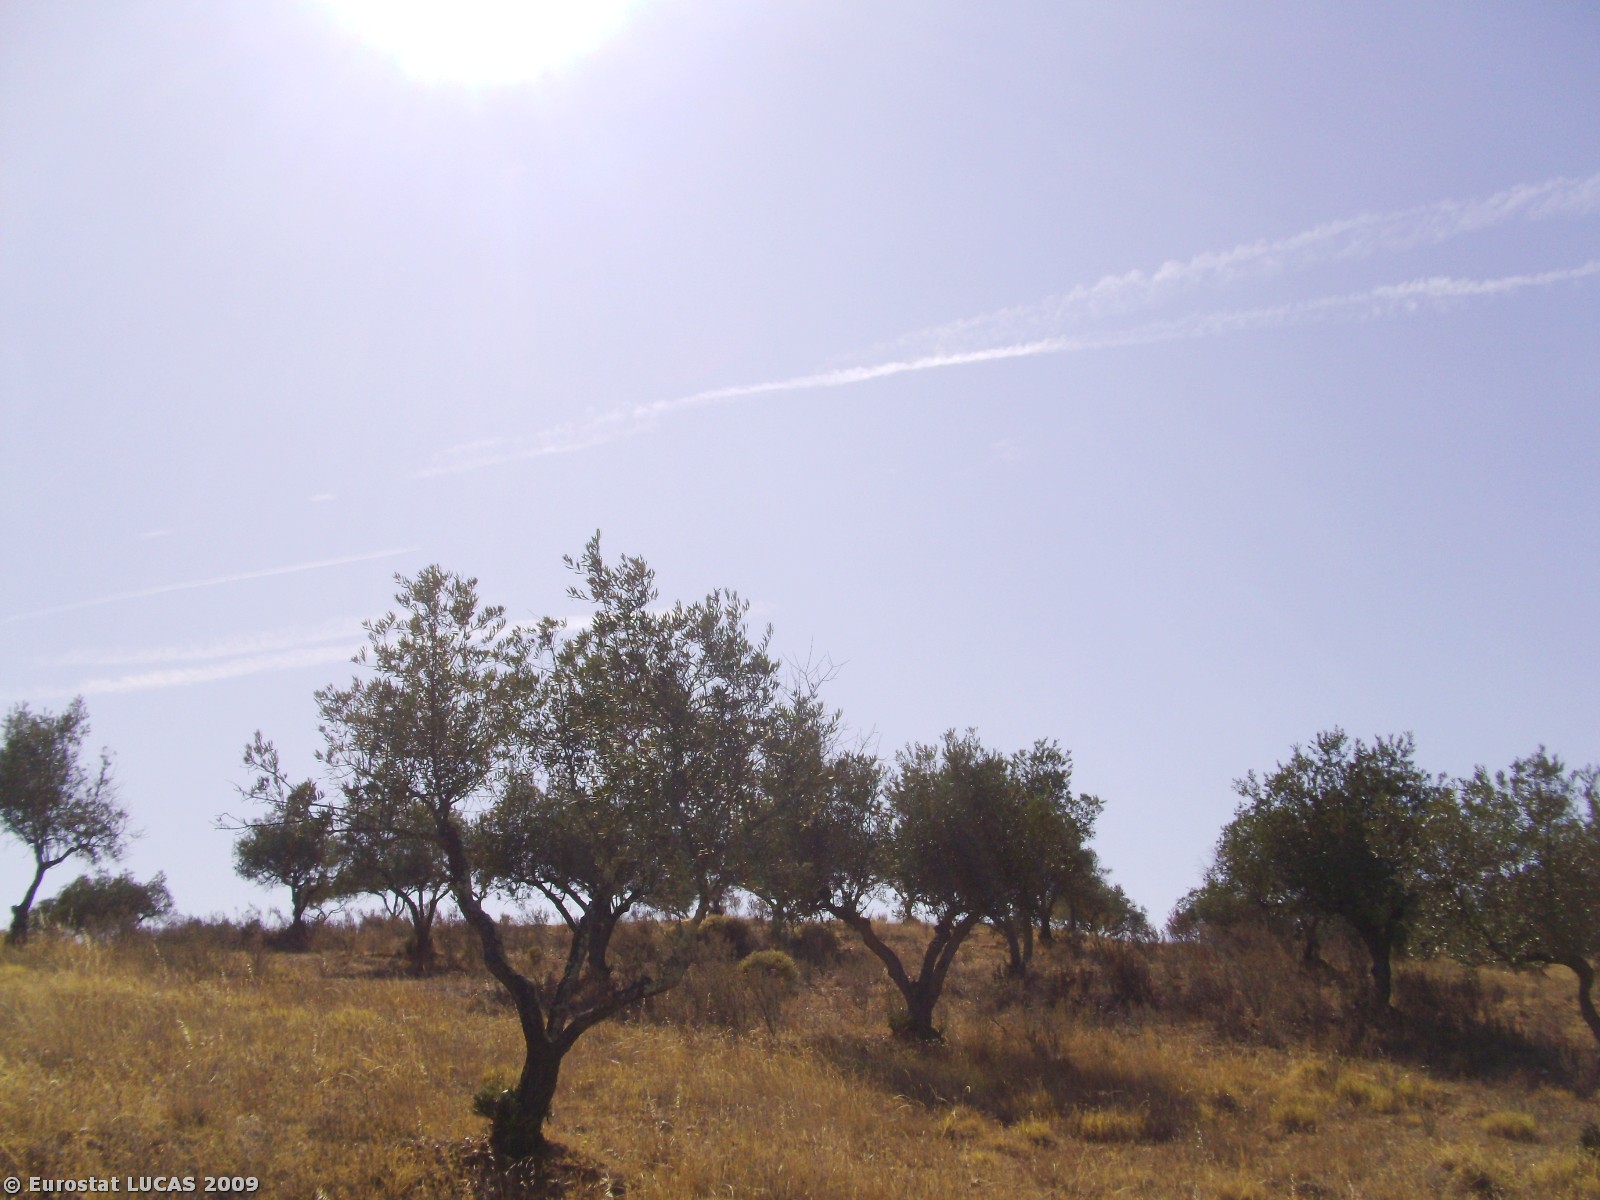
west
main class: Cropland
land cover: Olive groves
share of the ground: 25 - 50 %
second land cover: Spontaneously vegetated surfaces
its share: 25 - 50 %
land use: Agriculture (excluding fallow land and kitchen gardens)
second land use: Fallow land
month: August
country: PT
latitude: 38.1786
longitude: -7.6168
